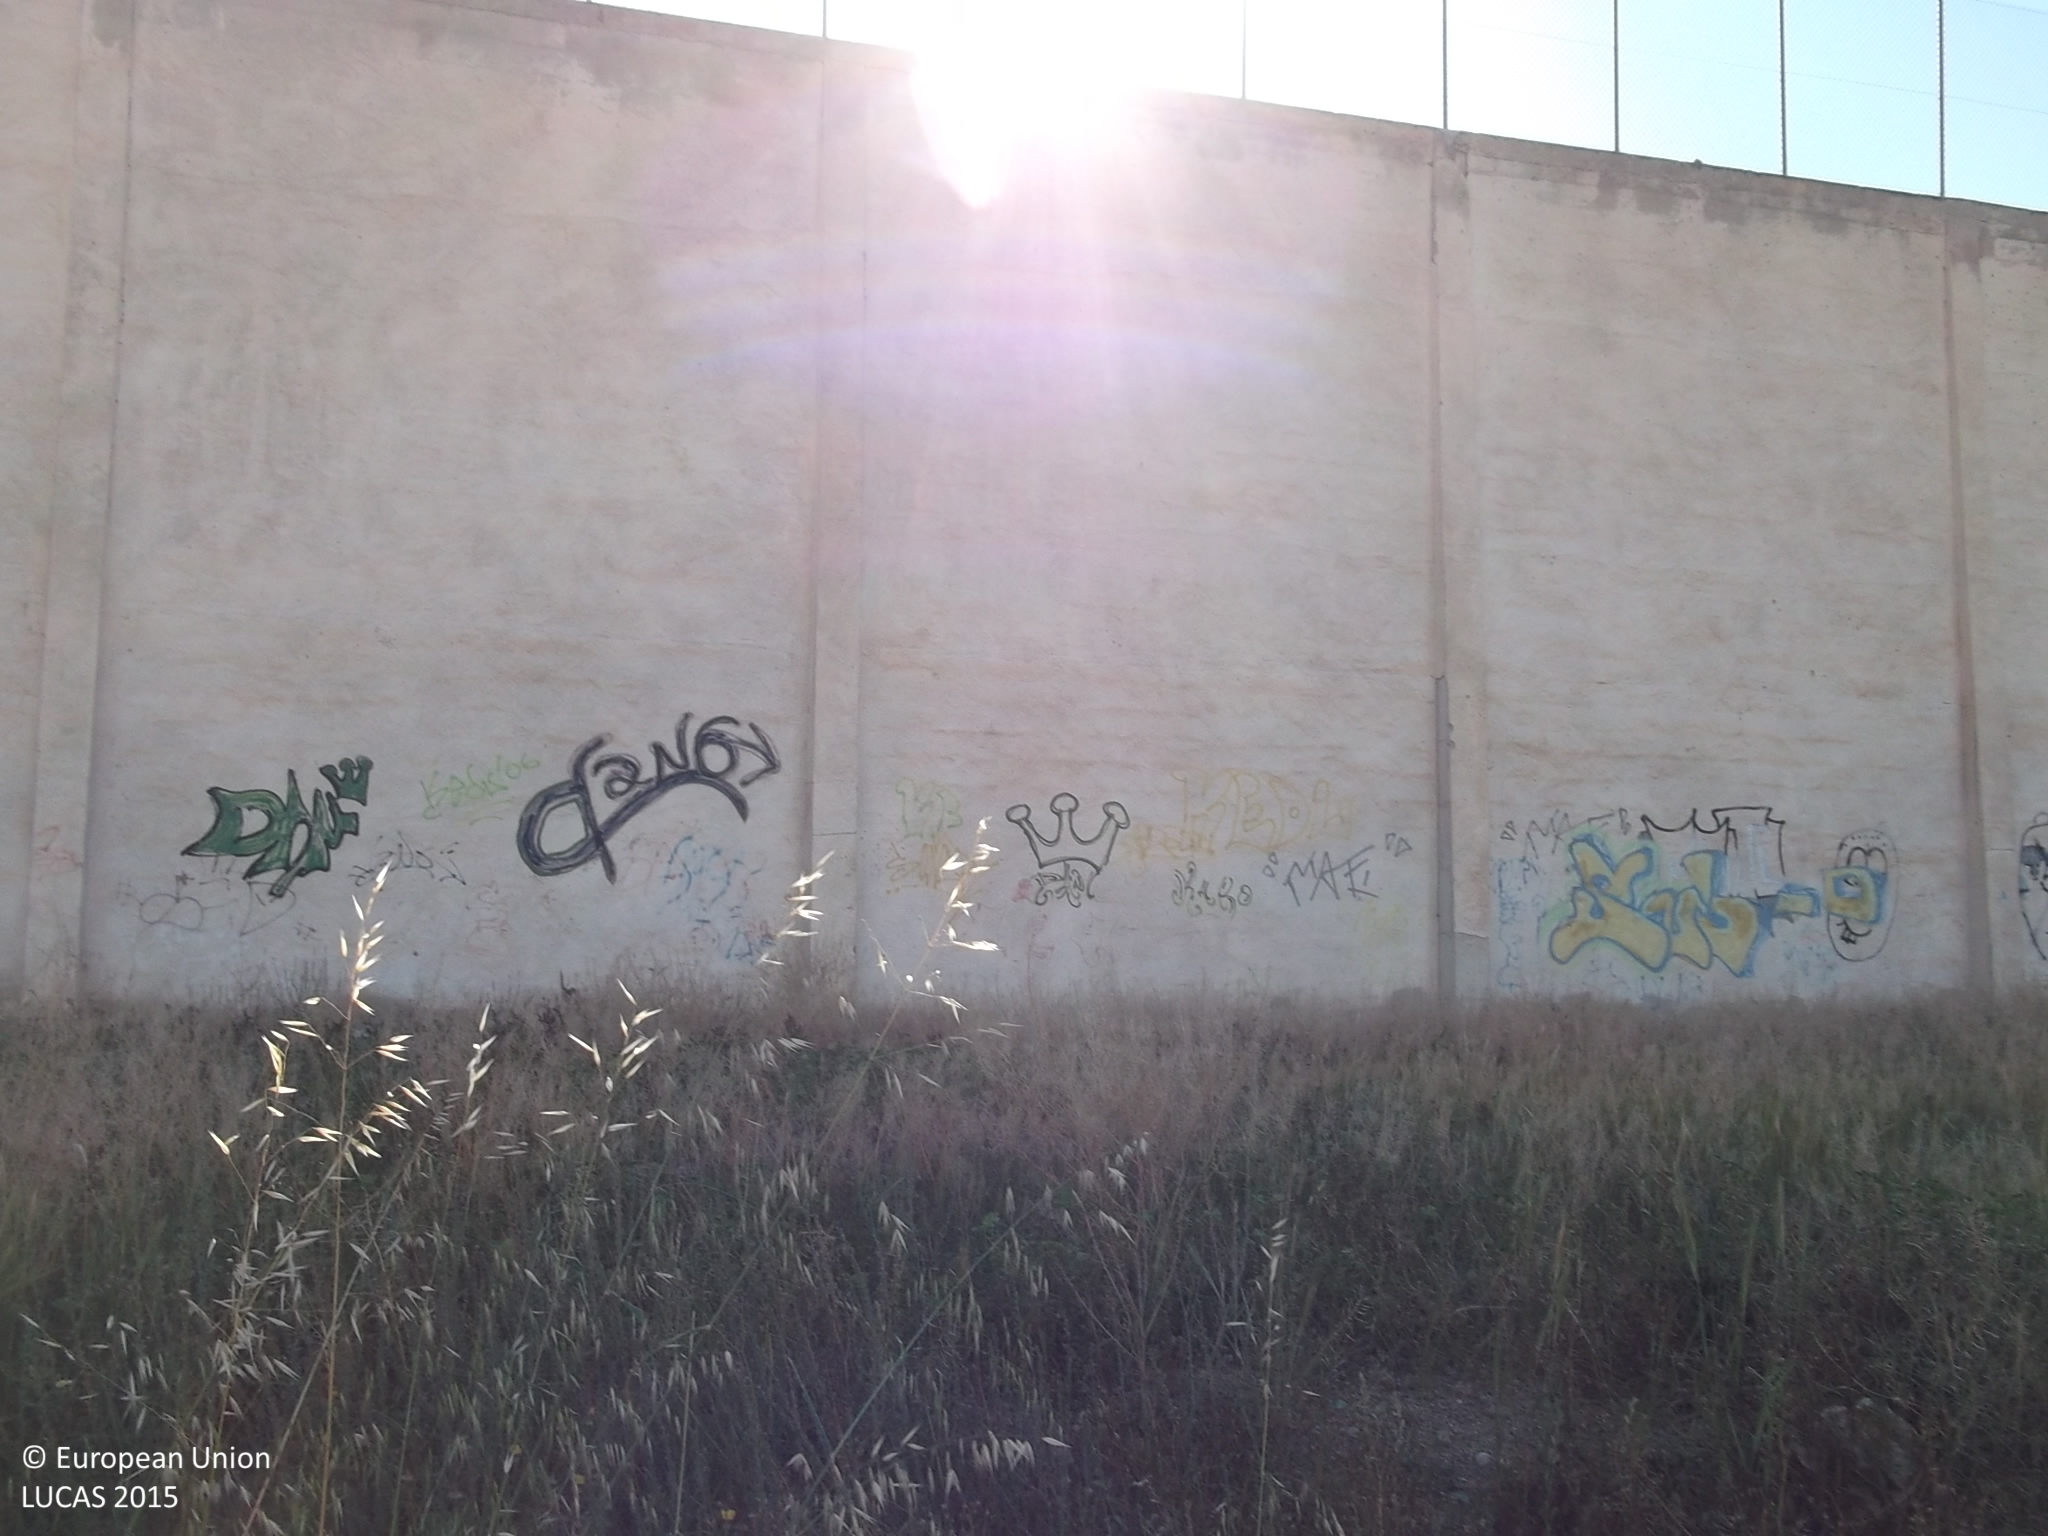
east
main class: Grassland
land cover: Spontaneously vegetated surfaces
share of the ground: > 75 %
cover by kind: herbaceous plants 90 %, consolidated bare surface 10 %
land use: Abandoned areas
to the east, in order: Spontaneously vegetated surfaces; Artificial constructions in urban areas; Managed hedges; Fences; Tracks; Spontaneously vegetated surfaces; Dry stone walls; Spontaneously vegetated surfaces; Groves; Spontaneously vegetated surfaces
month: April
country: ES
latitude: 38.2123
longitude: -1.3975
